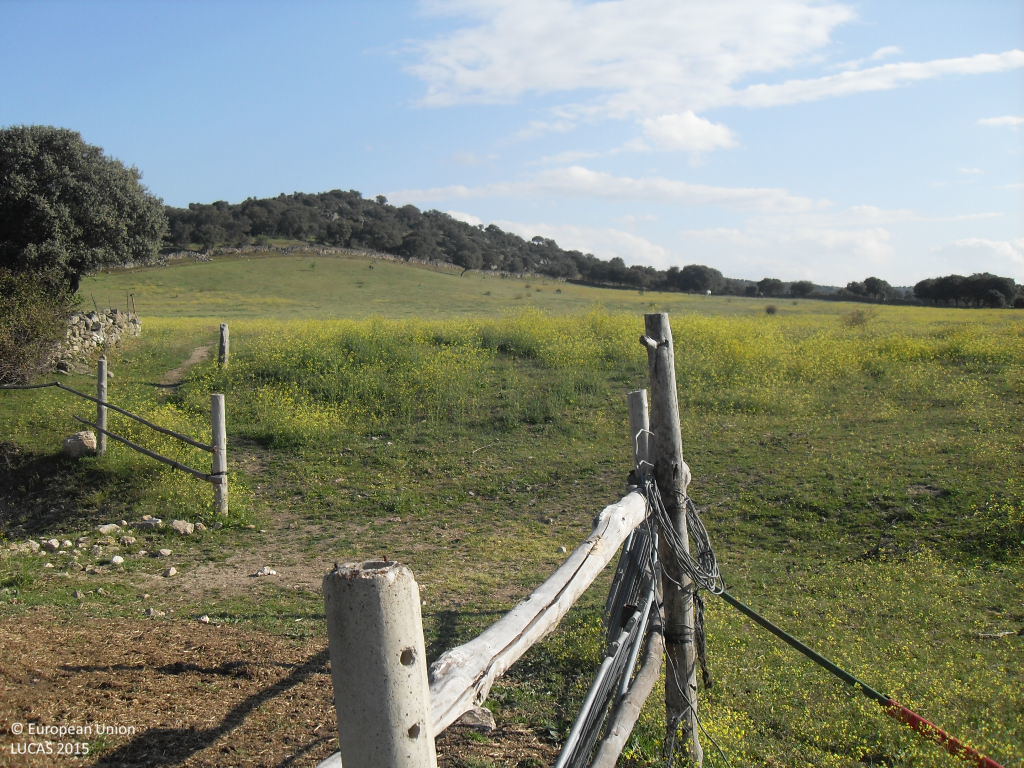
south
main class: Grassland
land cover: Grassland without tree/shrub cover
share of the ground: > 75 %
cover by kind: herbaceous plants 100 %
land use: Agriculture (excluding fallow land and kitchen gardens)
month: April
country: ES
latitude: 40.7125
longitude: -5.3012
